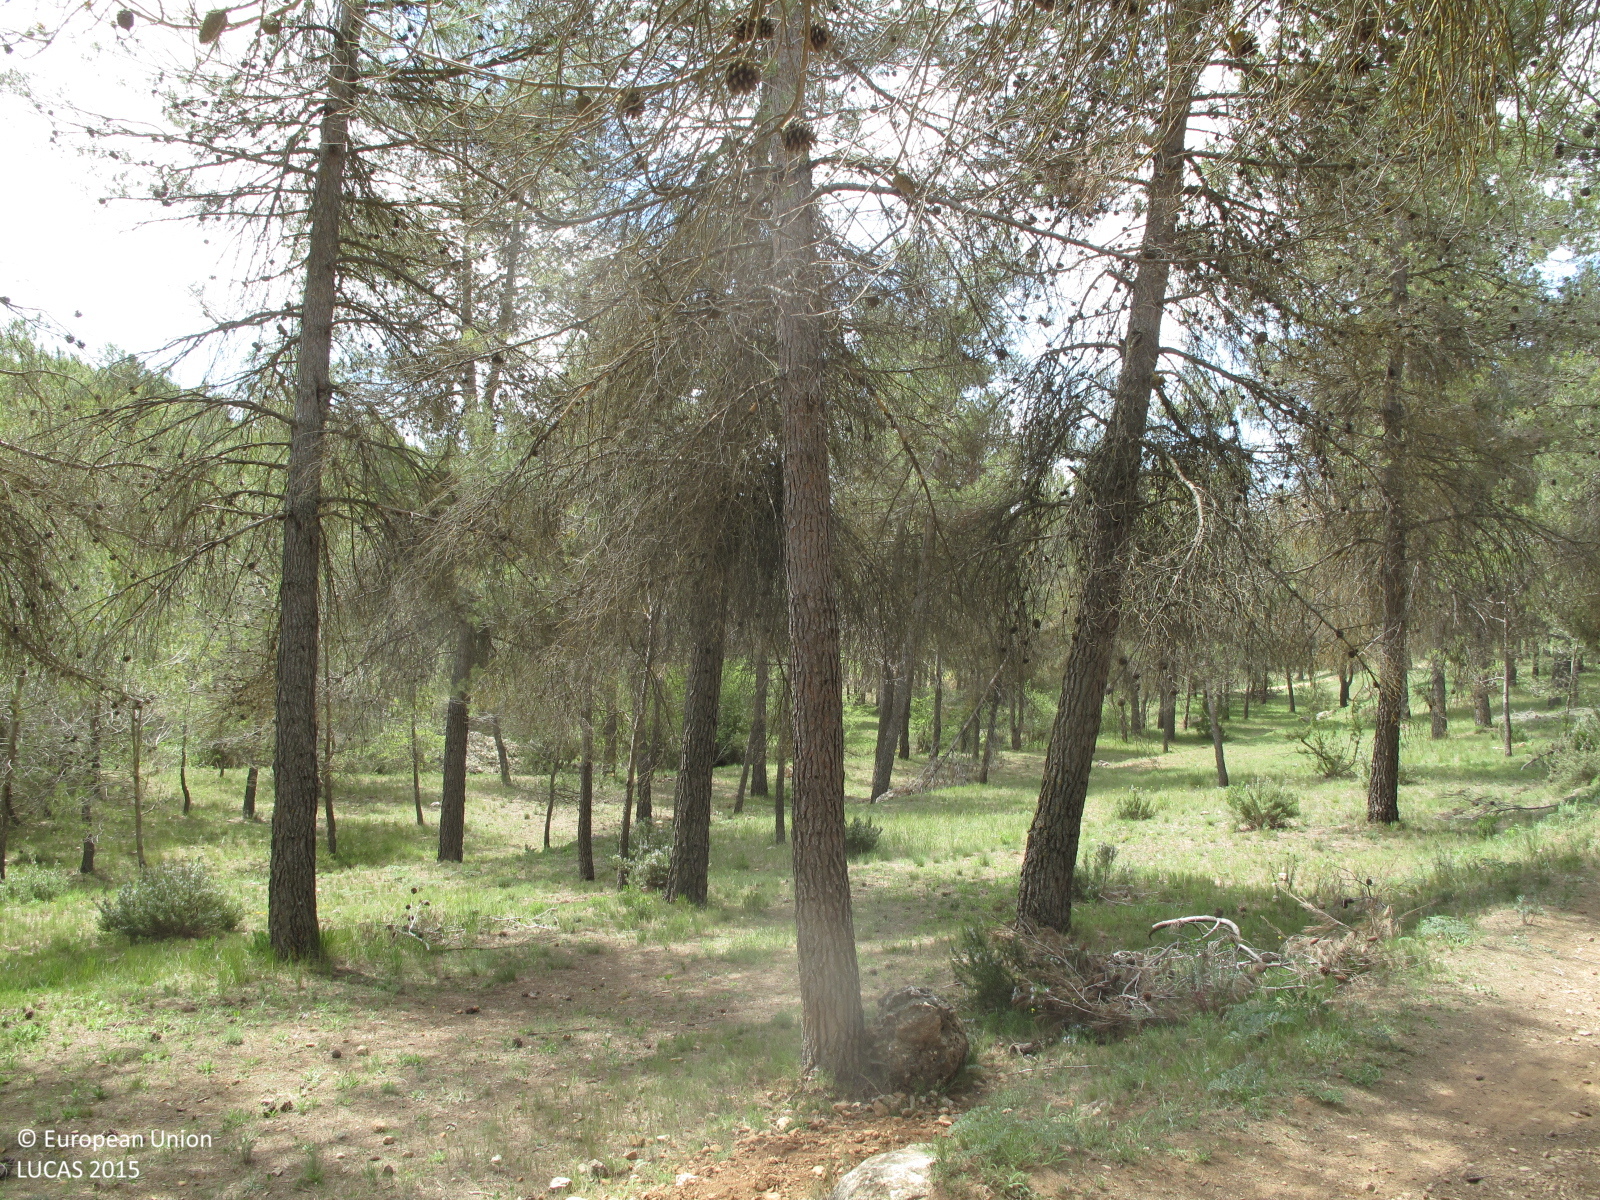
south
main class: Woodland
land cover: Pine dominated coniferous woodland
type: coniferous forest of the mediterranean region
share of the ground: 50 - 75 %
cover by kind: coniferous forest trees 50 %, consolidated bare surface 25 %, herbaceous plants 20 %, shrubs 5 %
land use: Semi-natural and natural areas not in use
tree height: > 5 m
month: May
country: ES
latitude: 38.7492
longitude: -0.5413
